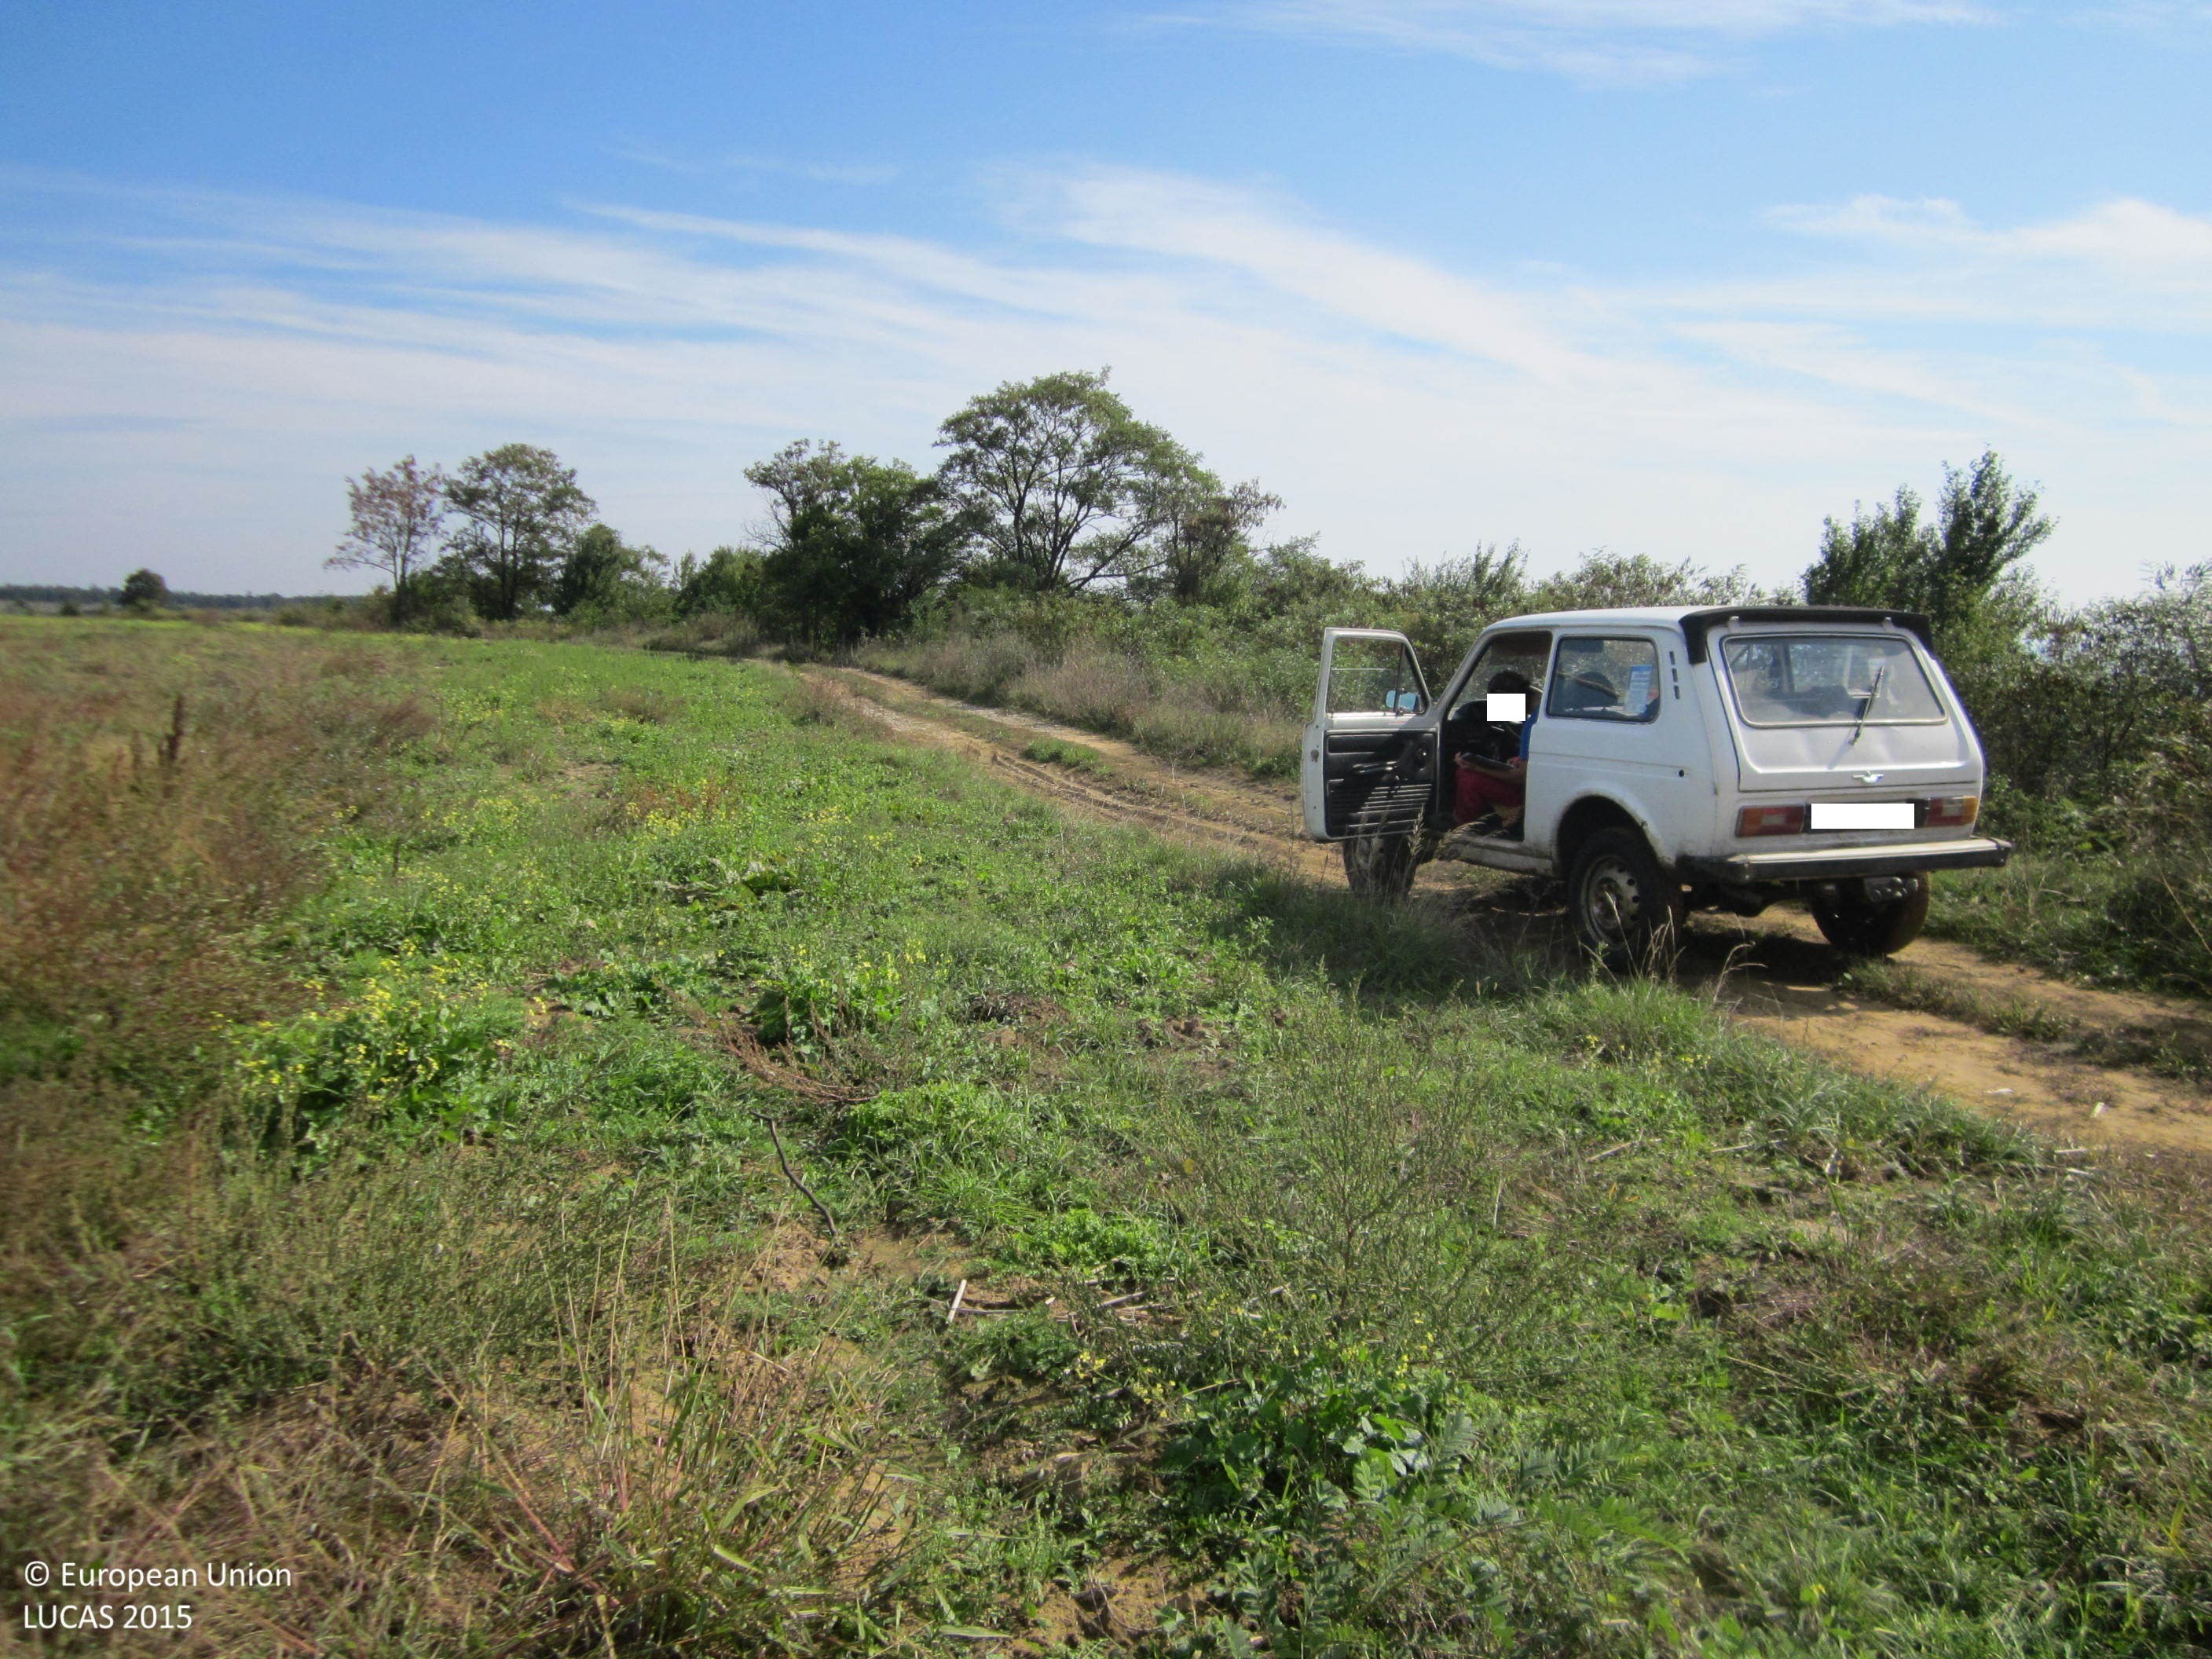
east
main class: Grassland
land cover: Spontaneously vegetated surfaces
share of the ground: > 75 %
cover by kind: herbaceous plants 100 %
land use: Semi-natural and natural areas not in use
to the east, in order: Spontaneously vegetated surfaces; Tracks; Shruby margins; Ditches and canals; Shrubland with sparse tree cover; Tracks; Sunflower
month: October
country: BG
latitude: 42.7947
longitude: 26.7417
